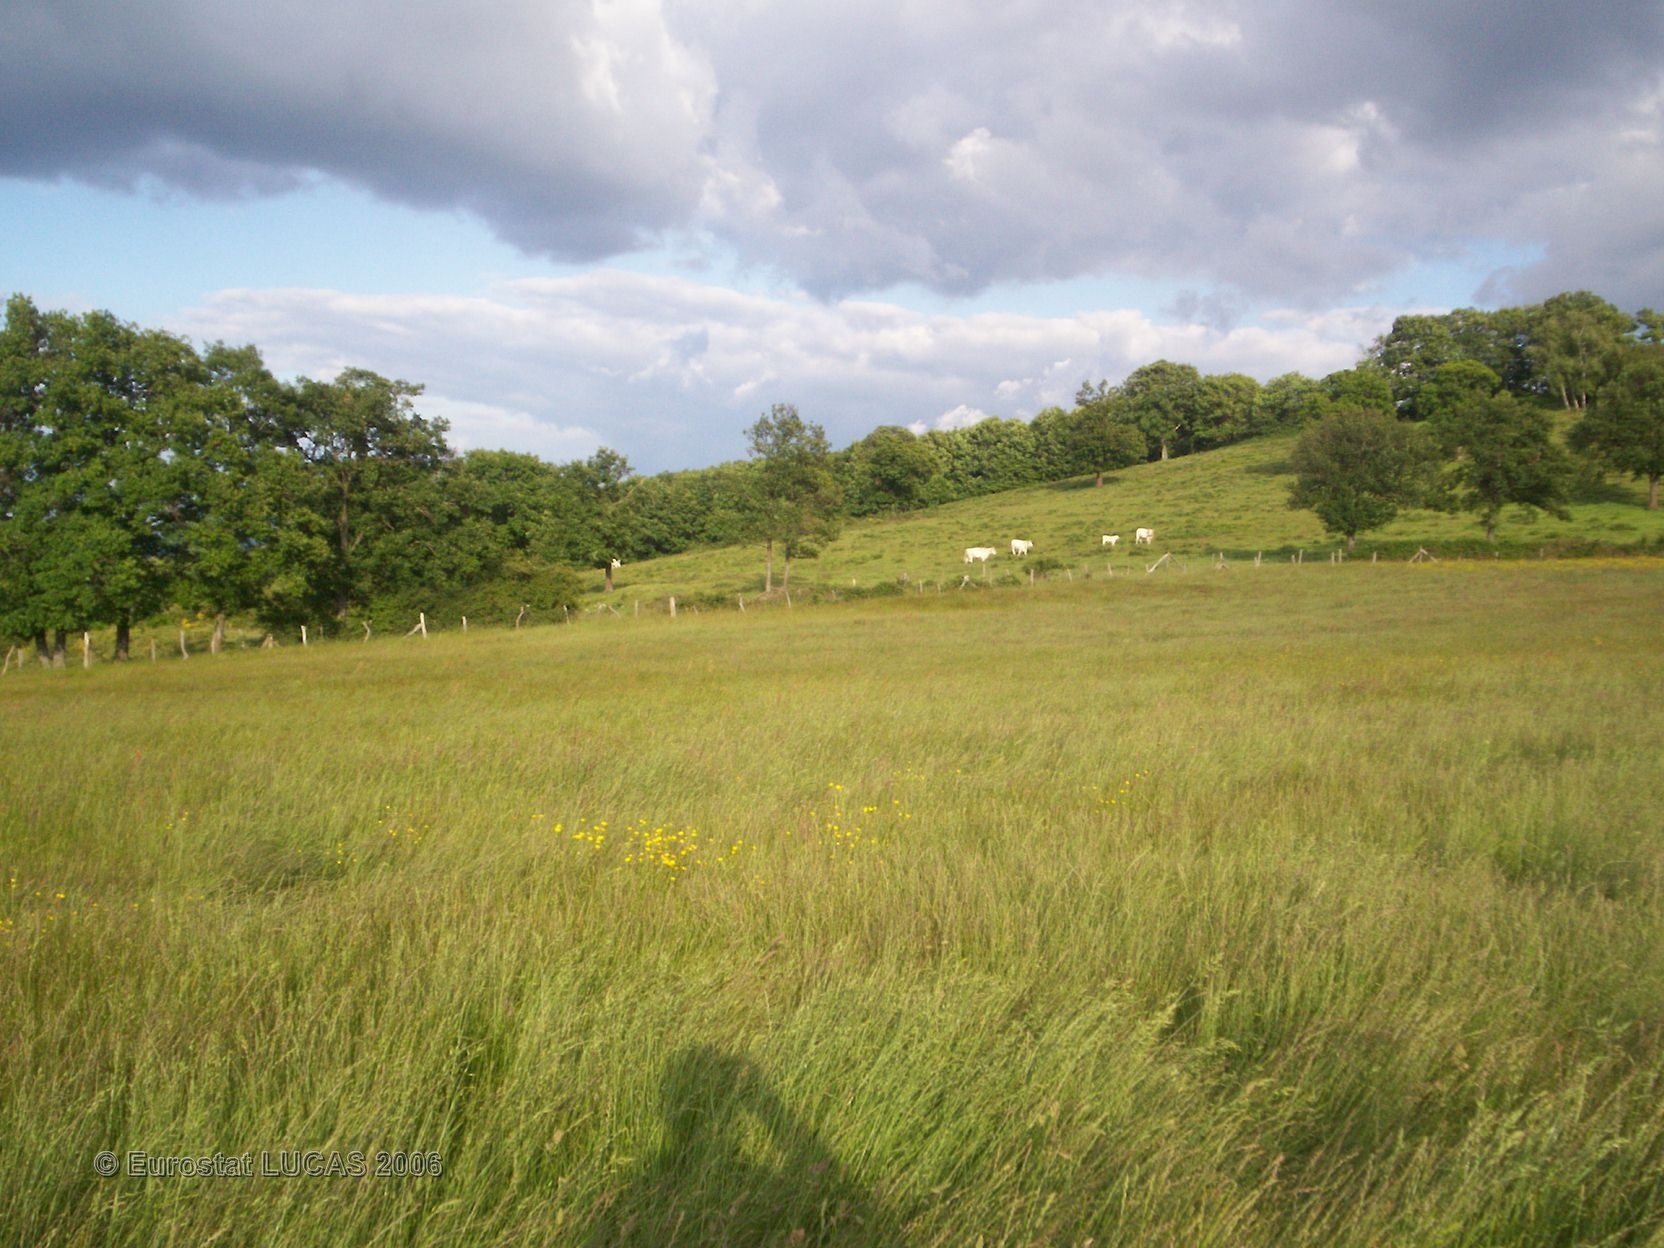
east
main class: Grassland
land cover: Grassland without tree/shrub cover
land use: Agriculture (excluding fallow land and kitchen gardens)
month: June
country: FR
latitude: 46.0958
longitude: 3.1564
